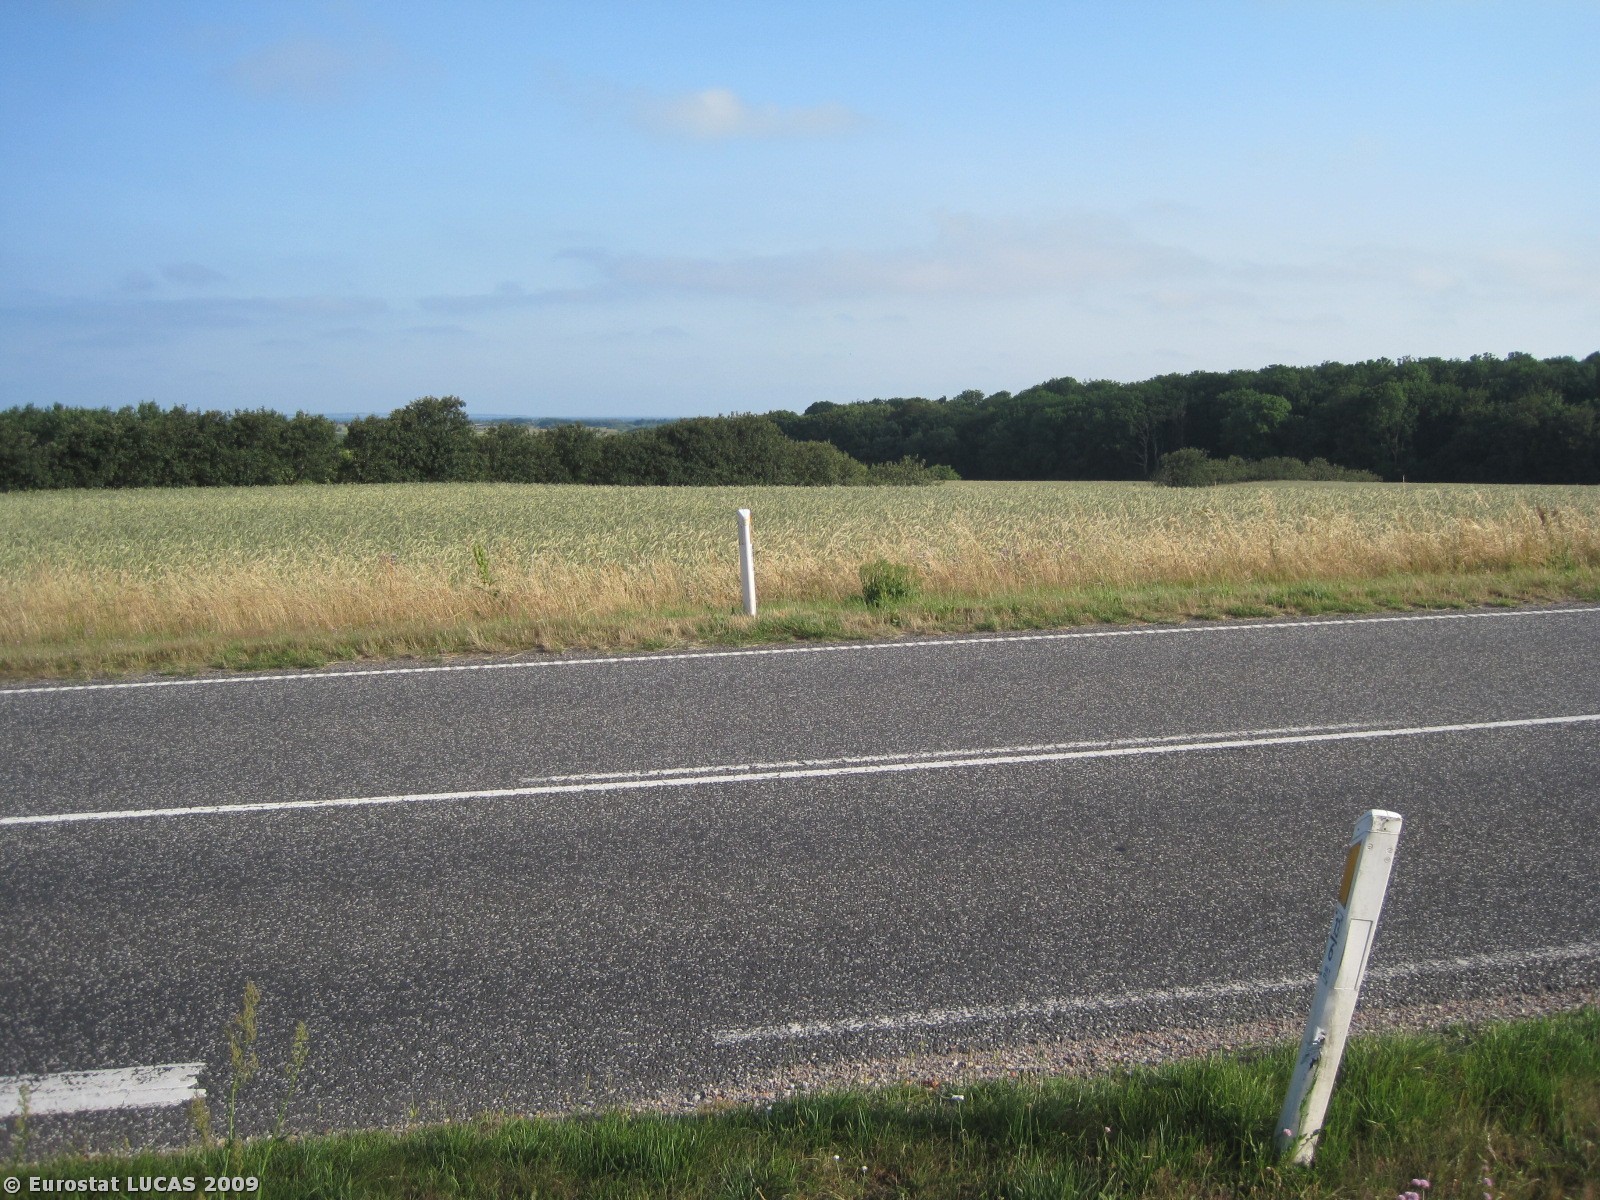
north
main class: Grassland
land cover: Grassland without tree/shrub cover
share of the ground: > 75 %
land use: Unused
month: July
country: DK
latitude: 56.4514
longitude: 8.7523
